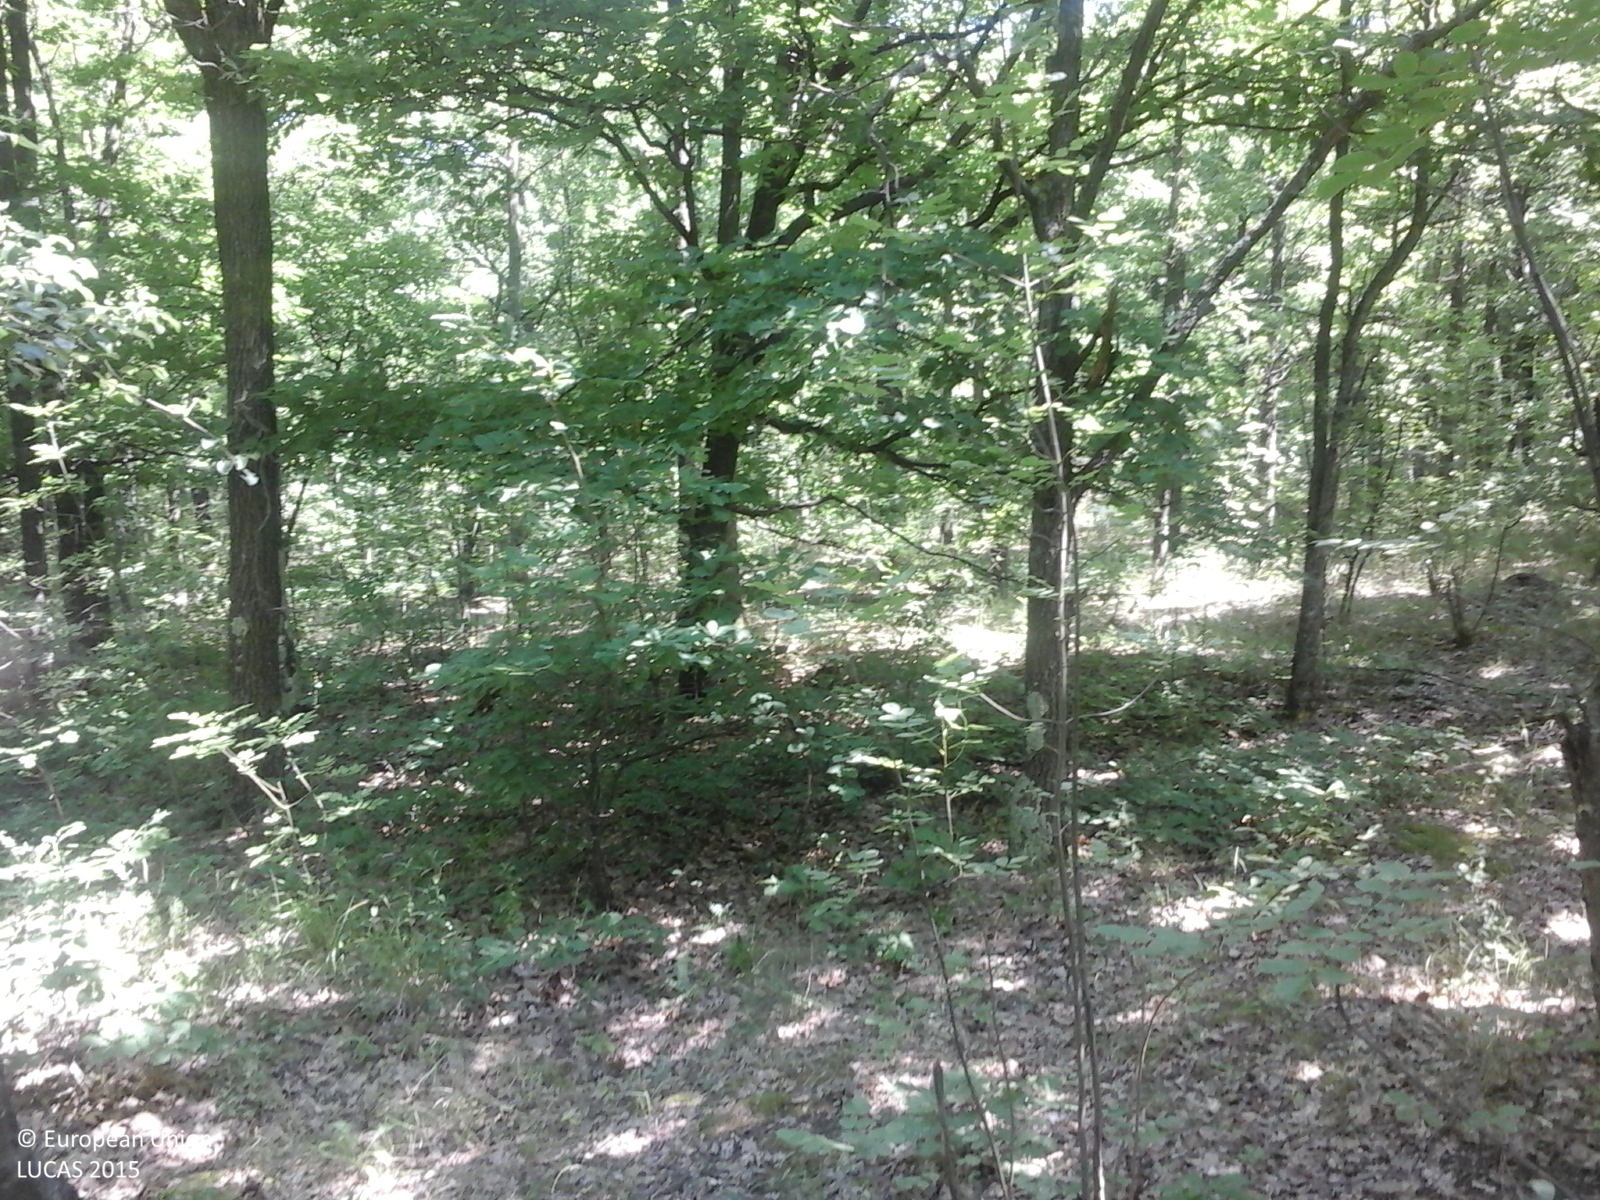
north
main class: Woodland
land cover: Broadleaved woodland
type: mesophytic deciduous forest
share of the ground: > 75 %
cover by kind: broadleaved forest trees 95 %, herbaceous plants 5 %
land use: Forestry
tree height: > 5 m
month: July
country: RO
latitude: 44.6806
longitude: 24.3640
